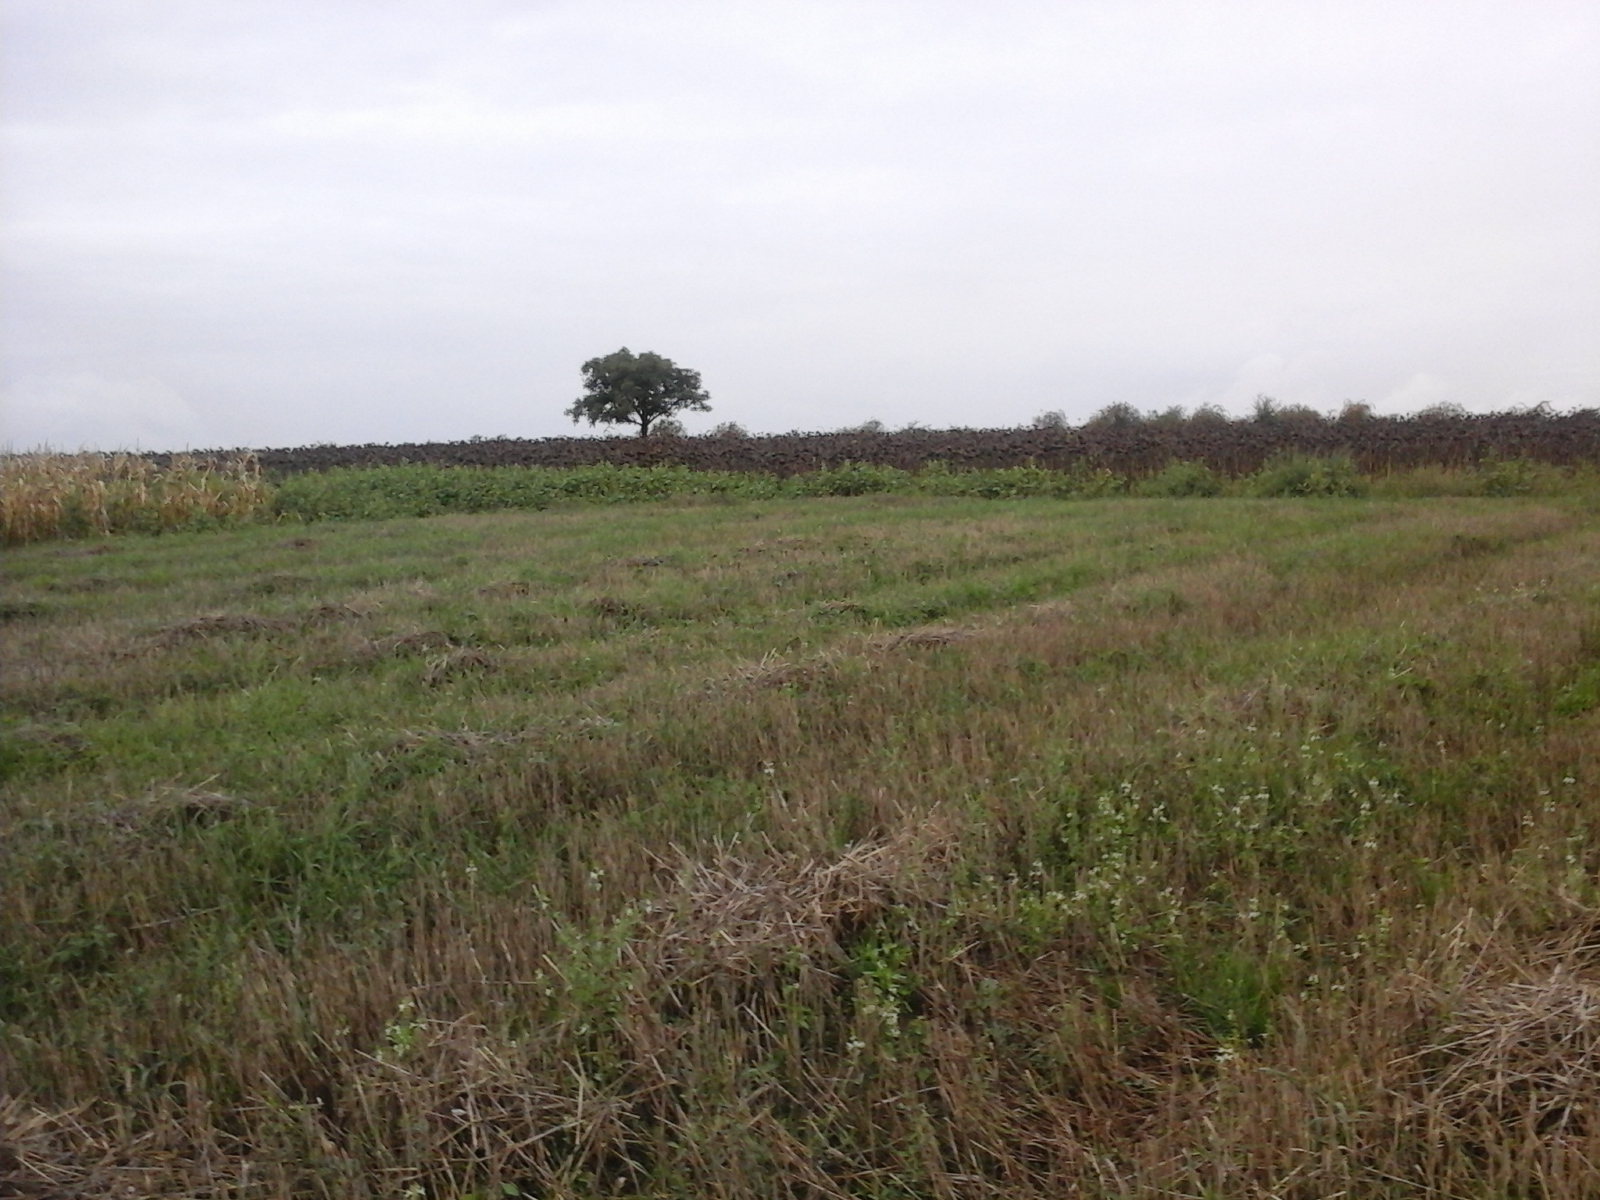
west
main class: Cropland
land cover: Common wheat
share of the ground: > 75 %
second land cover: Spontaneously vegetated surfaces
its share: 50 - 75 %
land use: Agriculture (excluding fallow land and kitchen gardens)
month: September
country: RO
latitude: 47.1489
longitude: 21.9825
